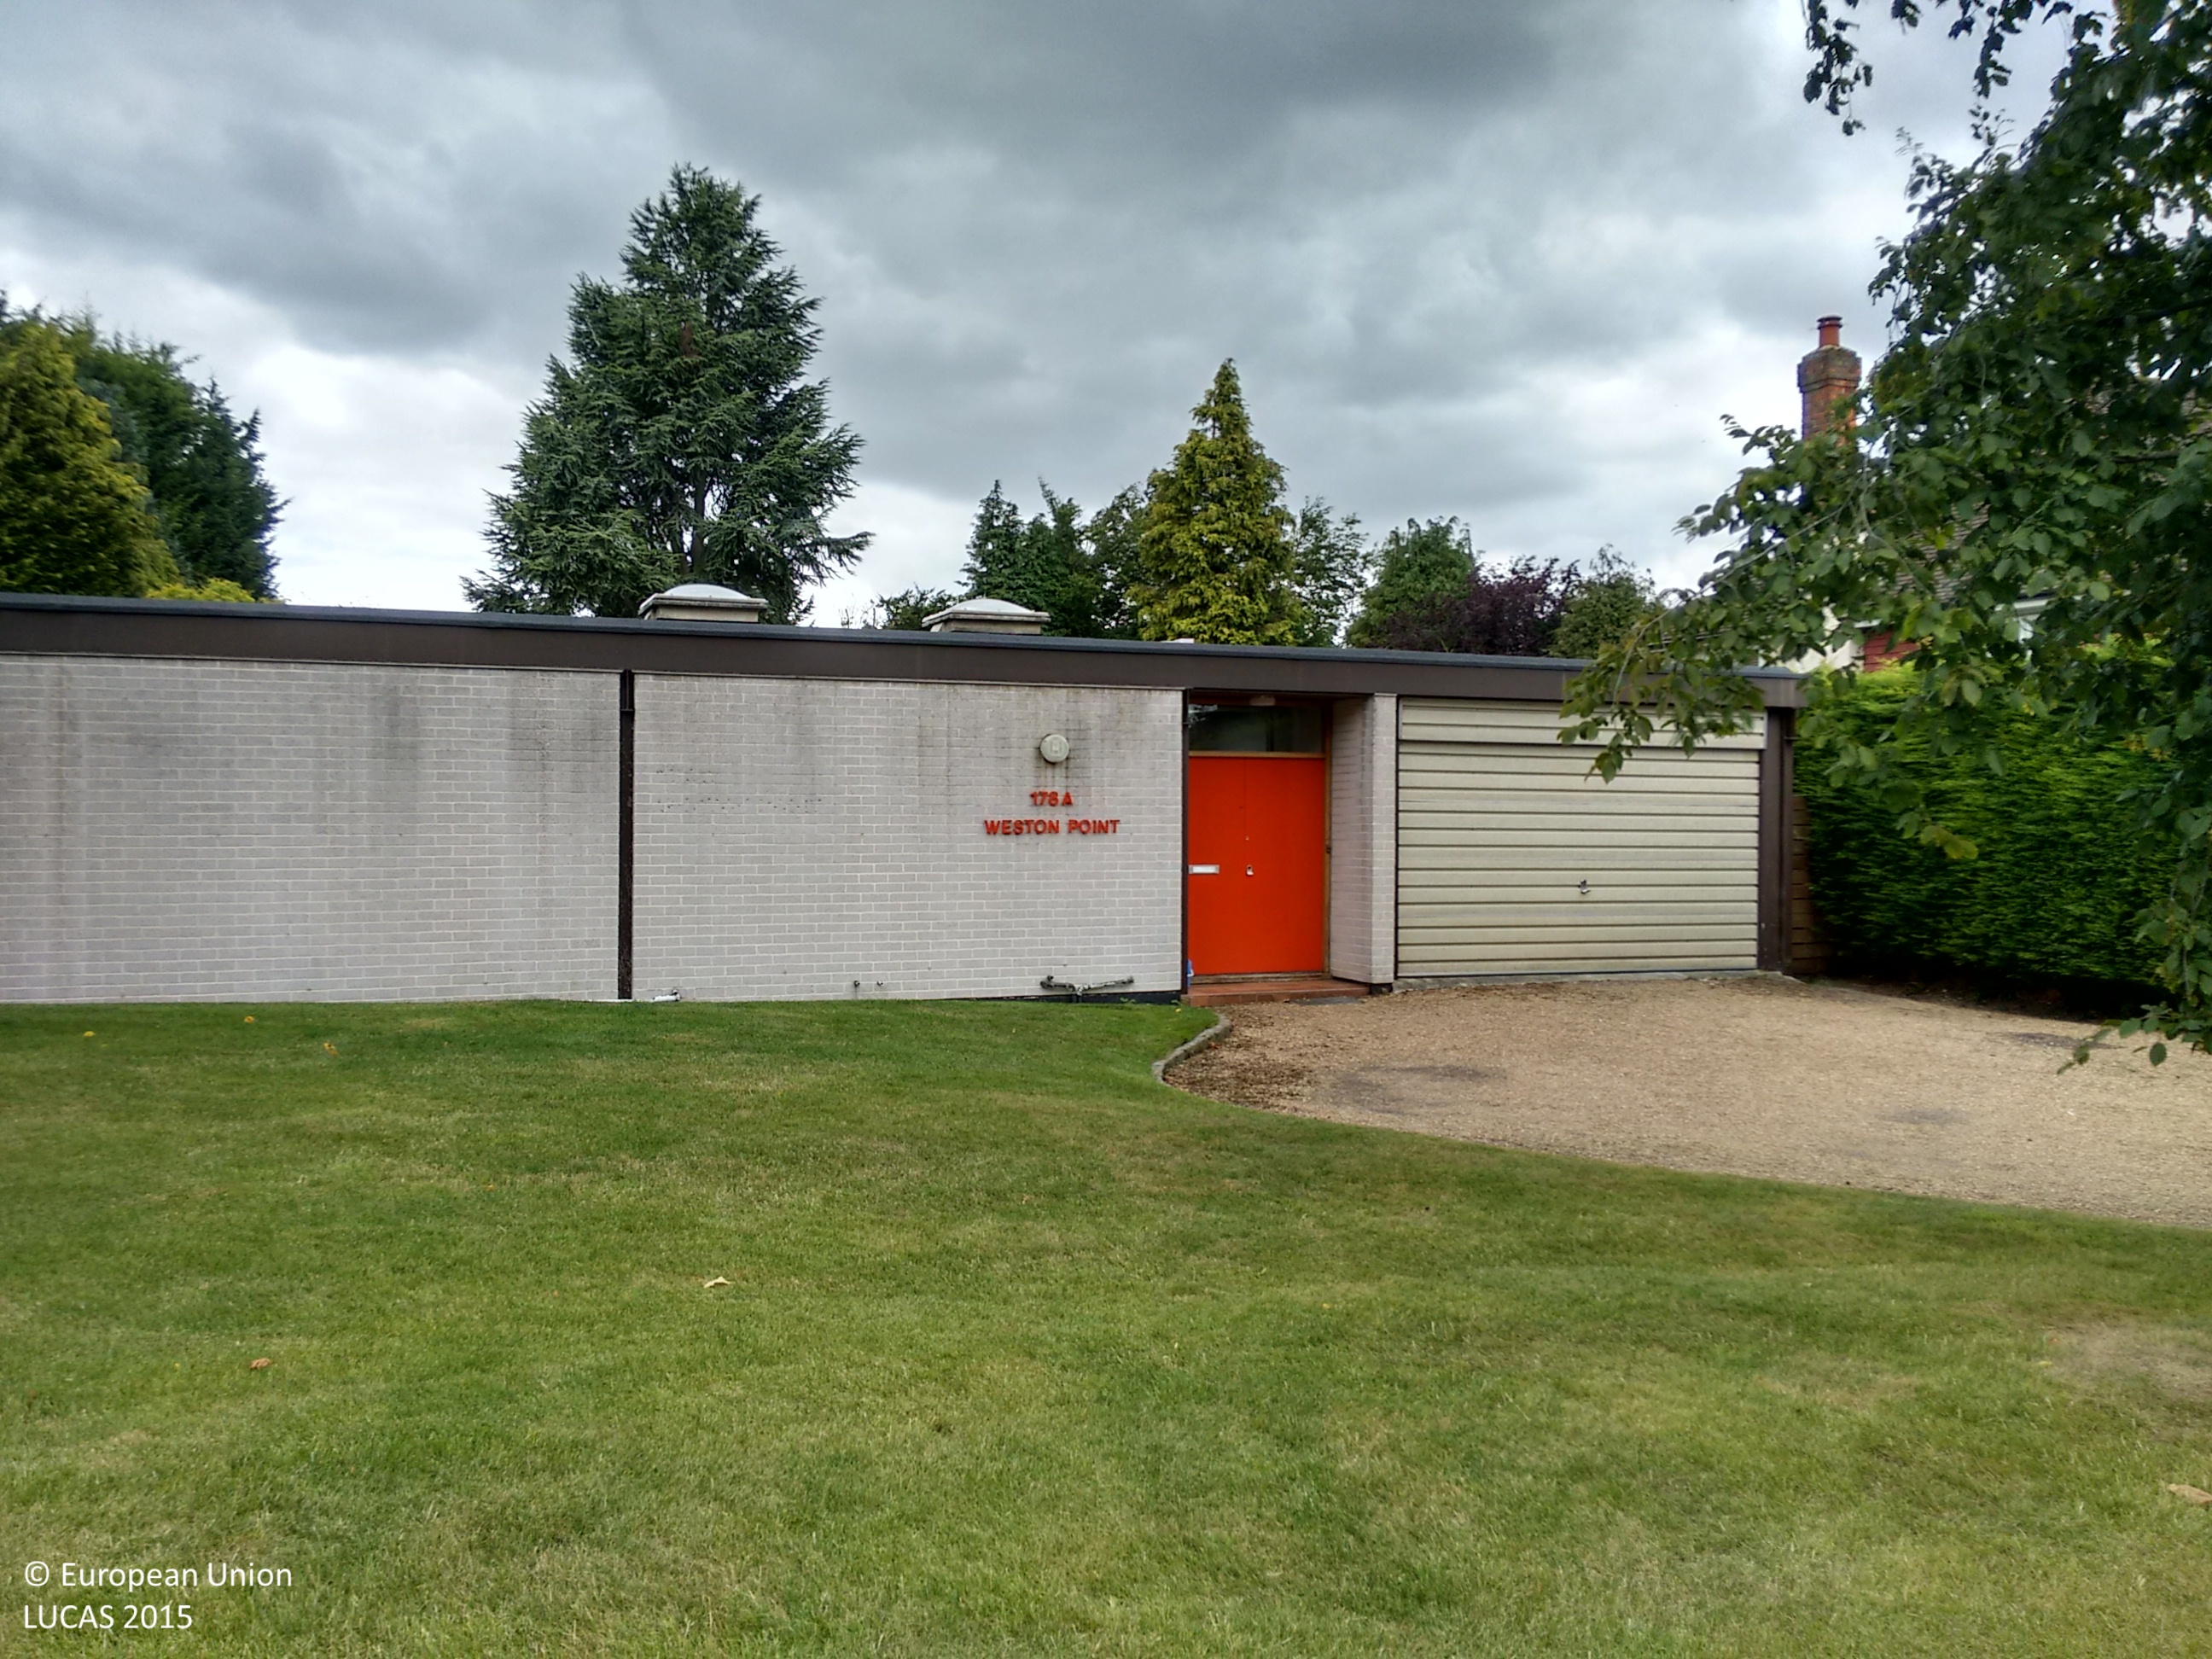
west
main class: Grassland
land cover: Grassland with sparse tree/shrub cover
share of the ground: > 75 %
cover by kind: herbaceous plants 95 %, coniferous forest trees 5 %
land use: Residential
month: August
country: GB
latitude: 51.3377
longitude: -0.2124
